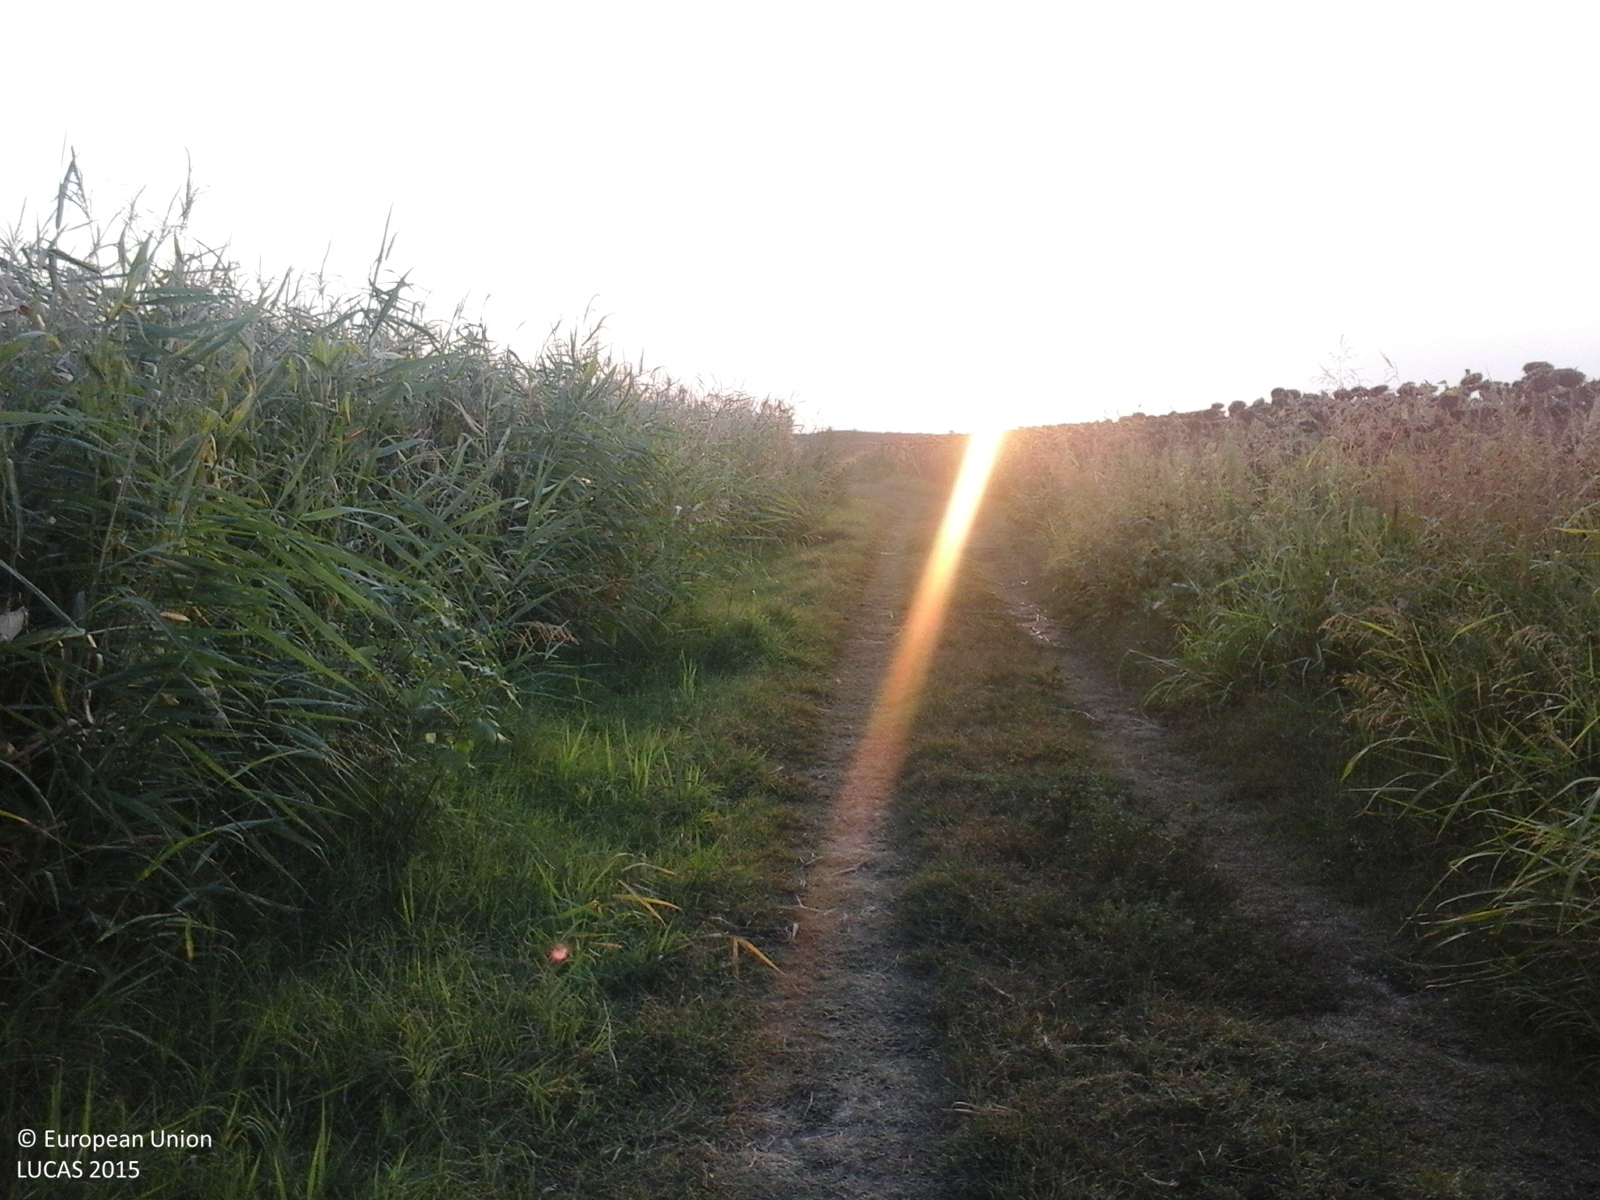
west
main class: Cropland
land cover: Sunflower
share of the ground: > 75 %
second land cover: Spontaneously vegetated surfaces
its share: 50 - 75 %
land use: Agriculture (excluding fallow land and kitchen gardens)
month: August
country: RO
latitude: 43.8900
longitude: 23.4538
